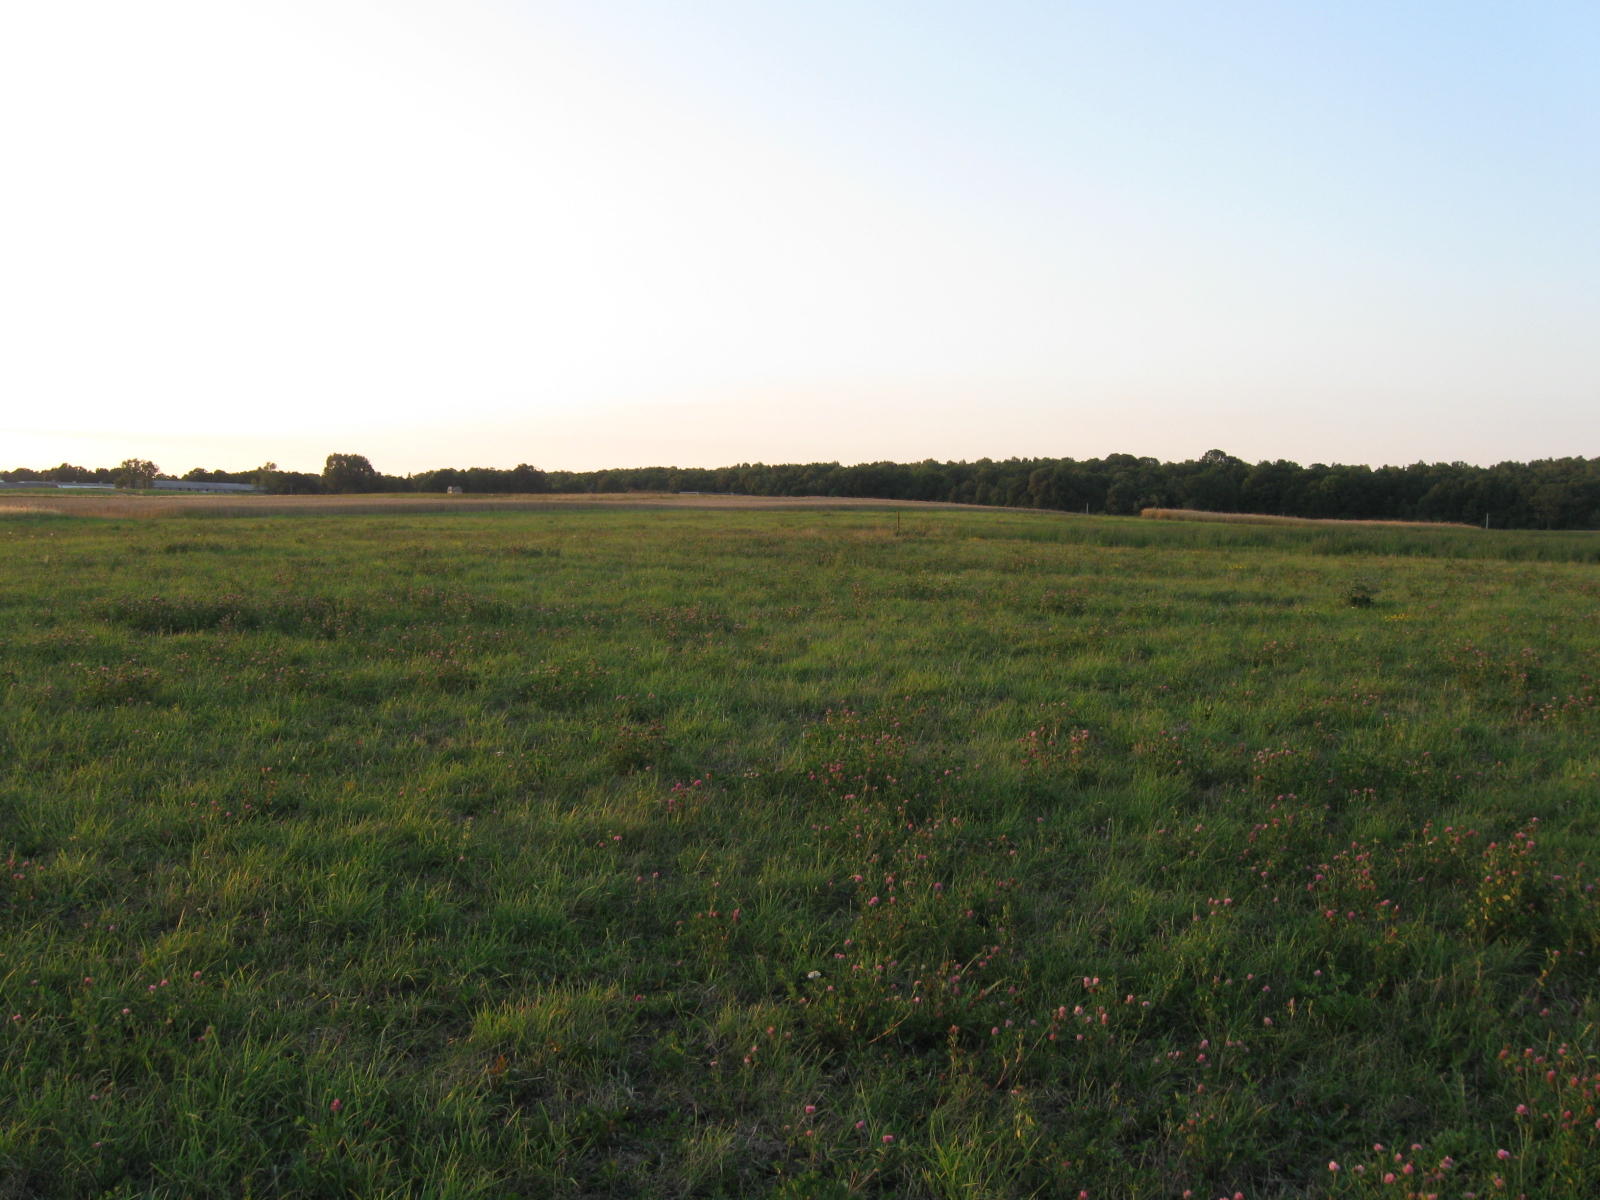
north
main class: Grassland
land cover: Grassland without tree/shrub cover
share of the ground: > 75 %
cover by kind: herbaceous plants 90 %, unconsolidated bare surface 10 %
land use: Agriculture (excluding fallow land and kitchen gardens)
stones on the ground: < 10 %
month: July
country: LT
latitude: 54.4209
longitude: 23.4114
